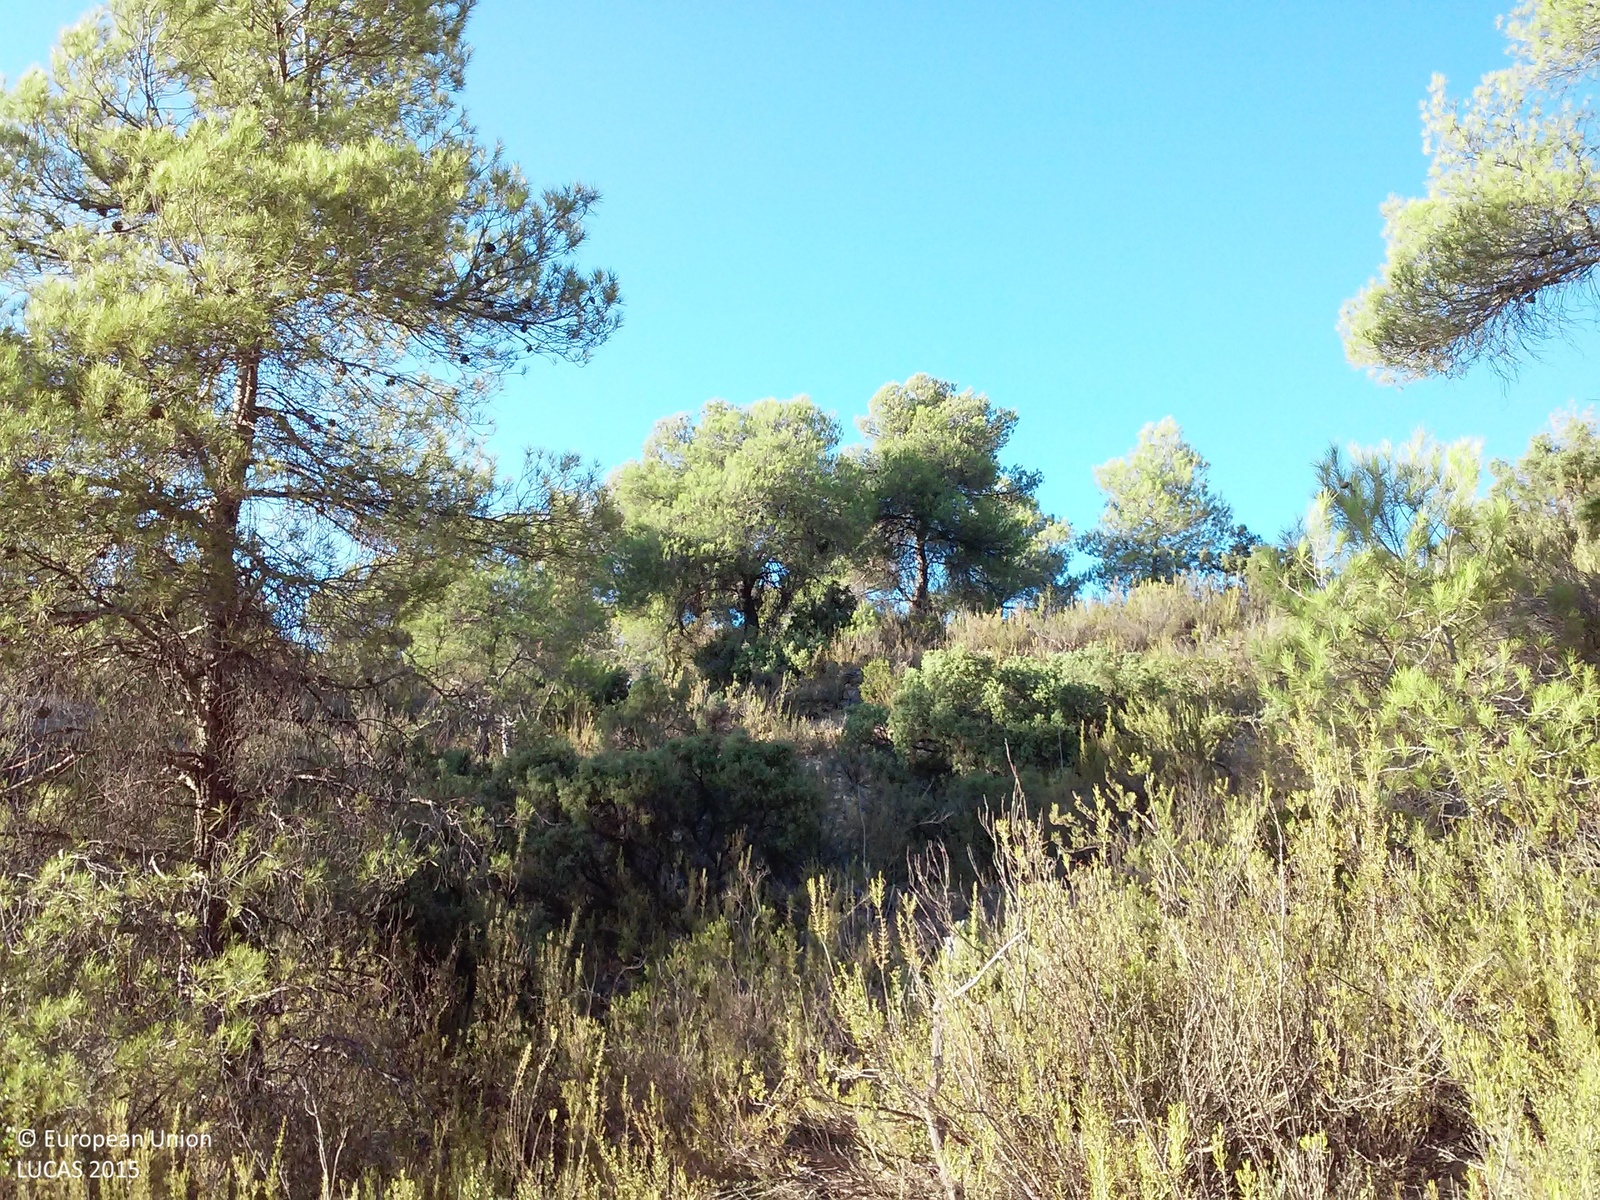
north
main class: Shrubland
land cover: Shrubland with sparse tree cover
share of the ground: 10 - 25 %
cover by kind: shrubs 50 %, consolidated bare surface 45 %, broadleaved forest trees 5 %
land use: Semi-natural and natural areas not in use
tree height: < 5 m
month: September
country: ES
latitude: 41.2210
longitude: 0.6510
